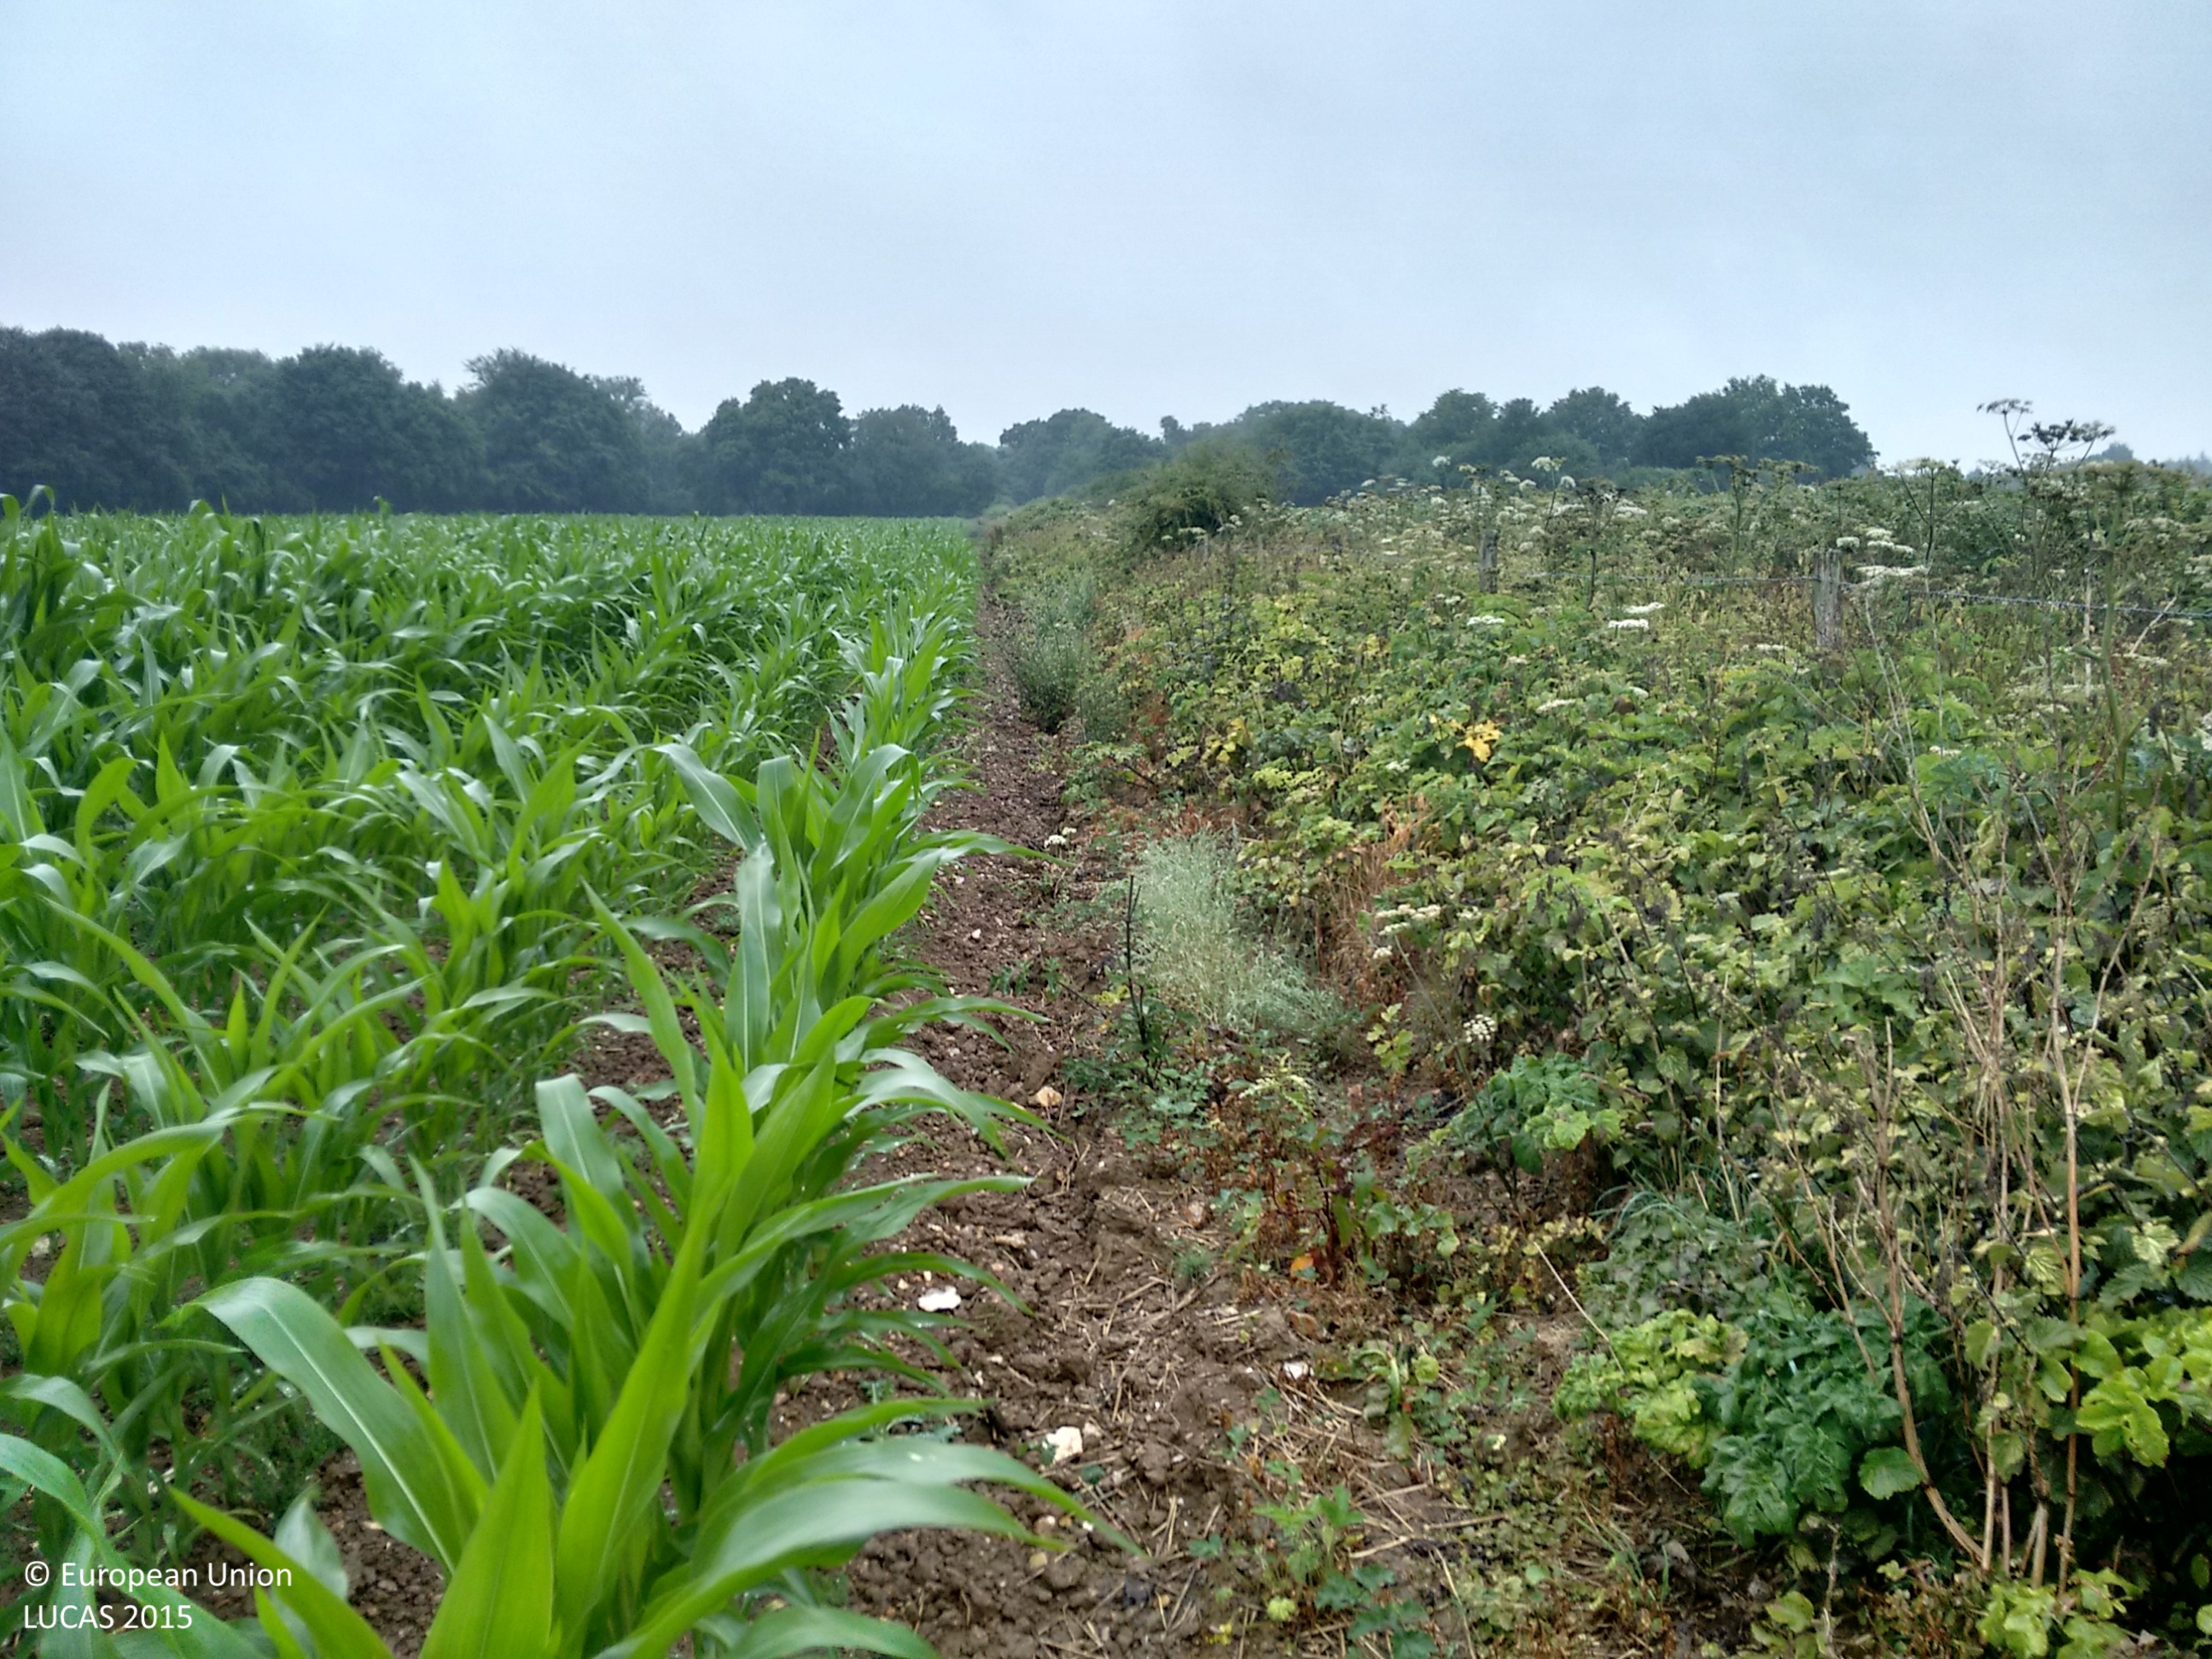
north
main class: Cropland
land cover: Maize
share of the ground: 50 - 75 %
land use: Agriculture (excluding fallow land and kitchen gardens)
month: July
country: GB
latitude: 51.1912
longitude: -1.0195
